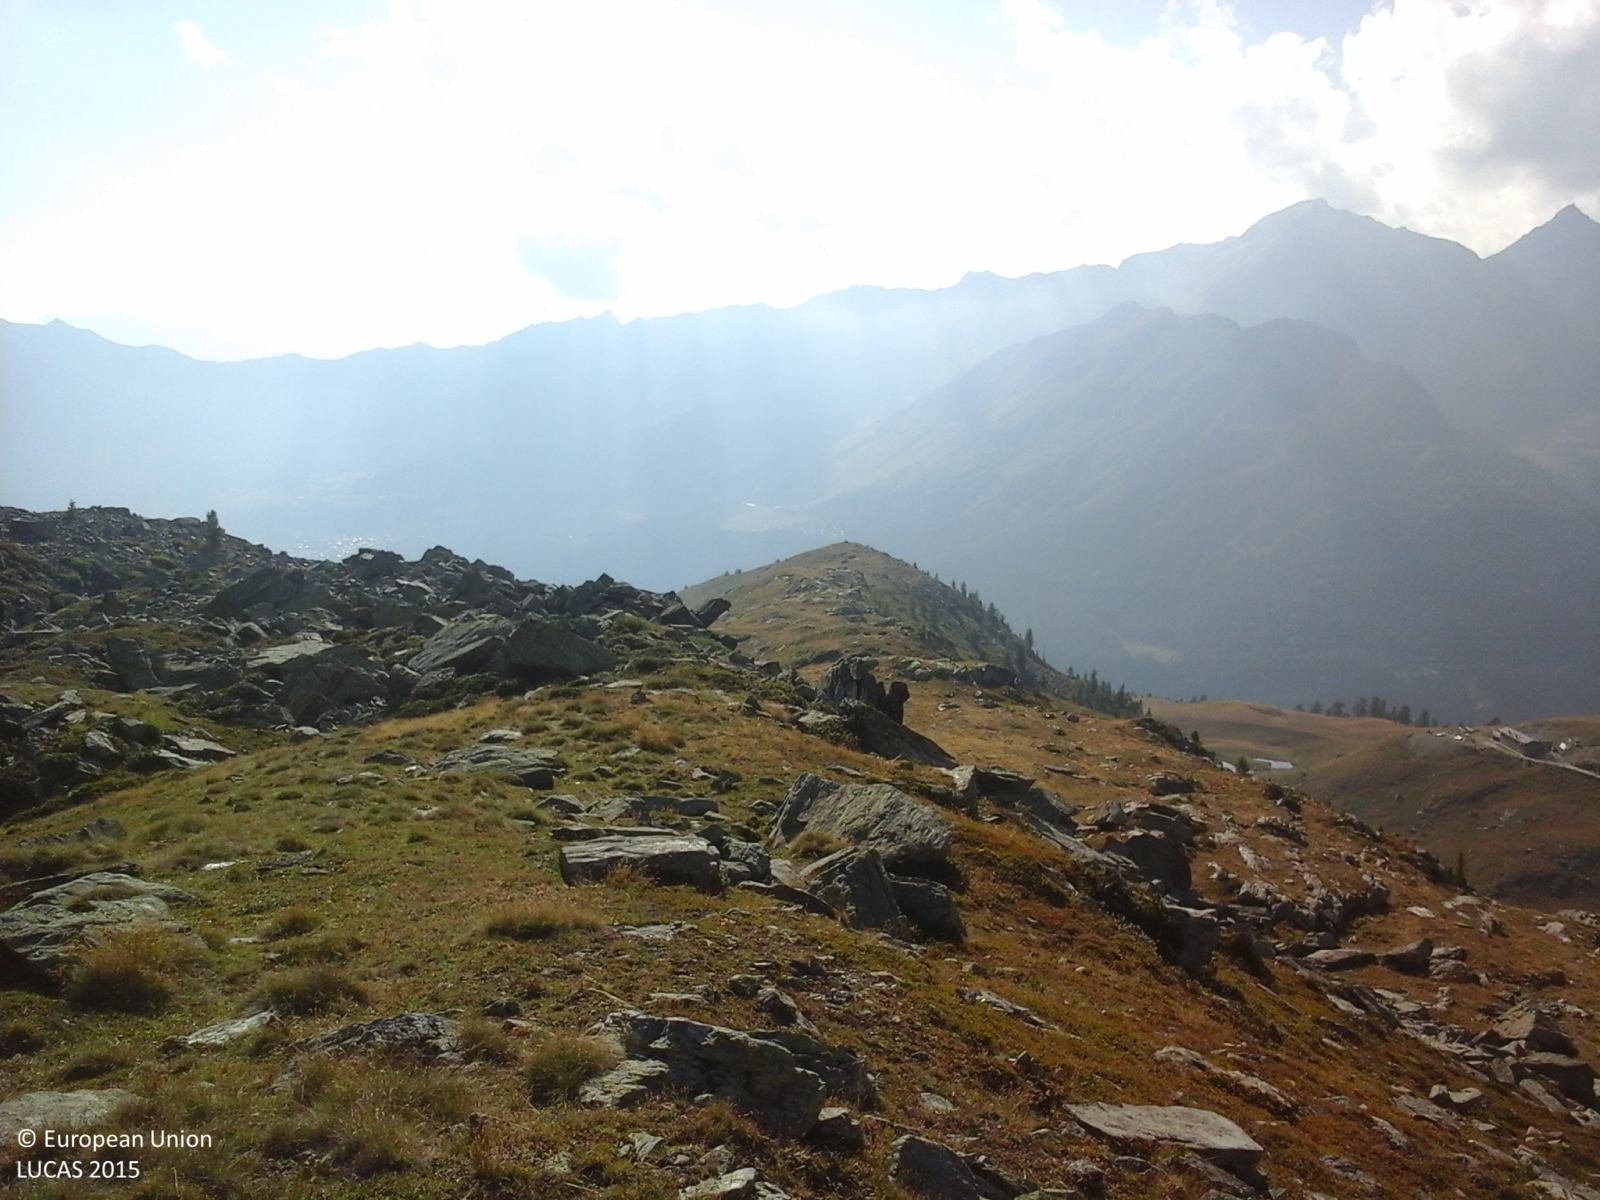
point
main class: Grassland
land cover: Grassland without tree/shrub cover
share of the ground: > 75 %
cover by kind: herbaceous plants 100 %
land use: Agriculture (excluding fallow land and kitchen gardens)
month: August
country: IT
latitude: 45.8410
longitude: 7.7499
